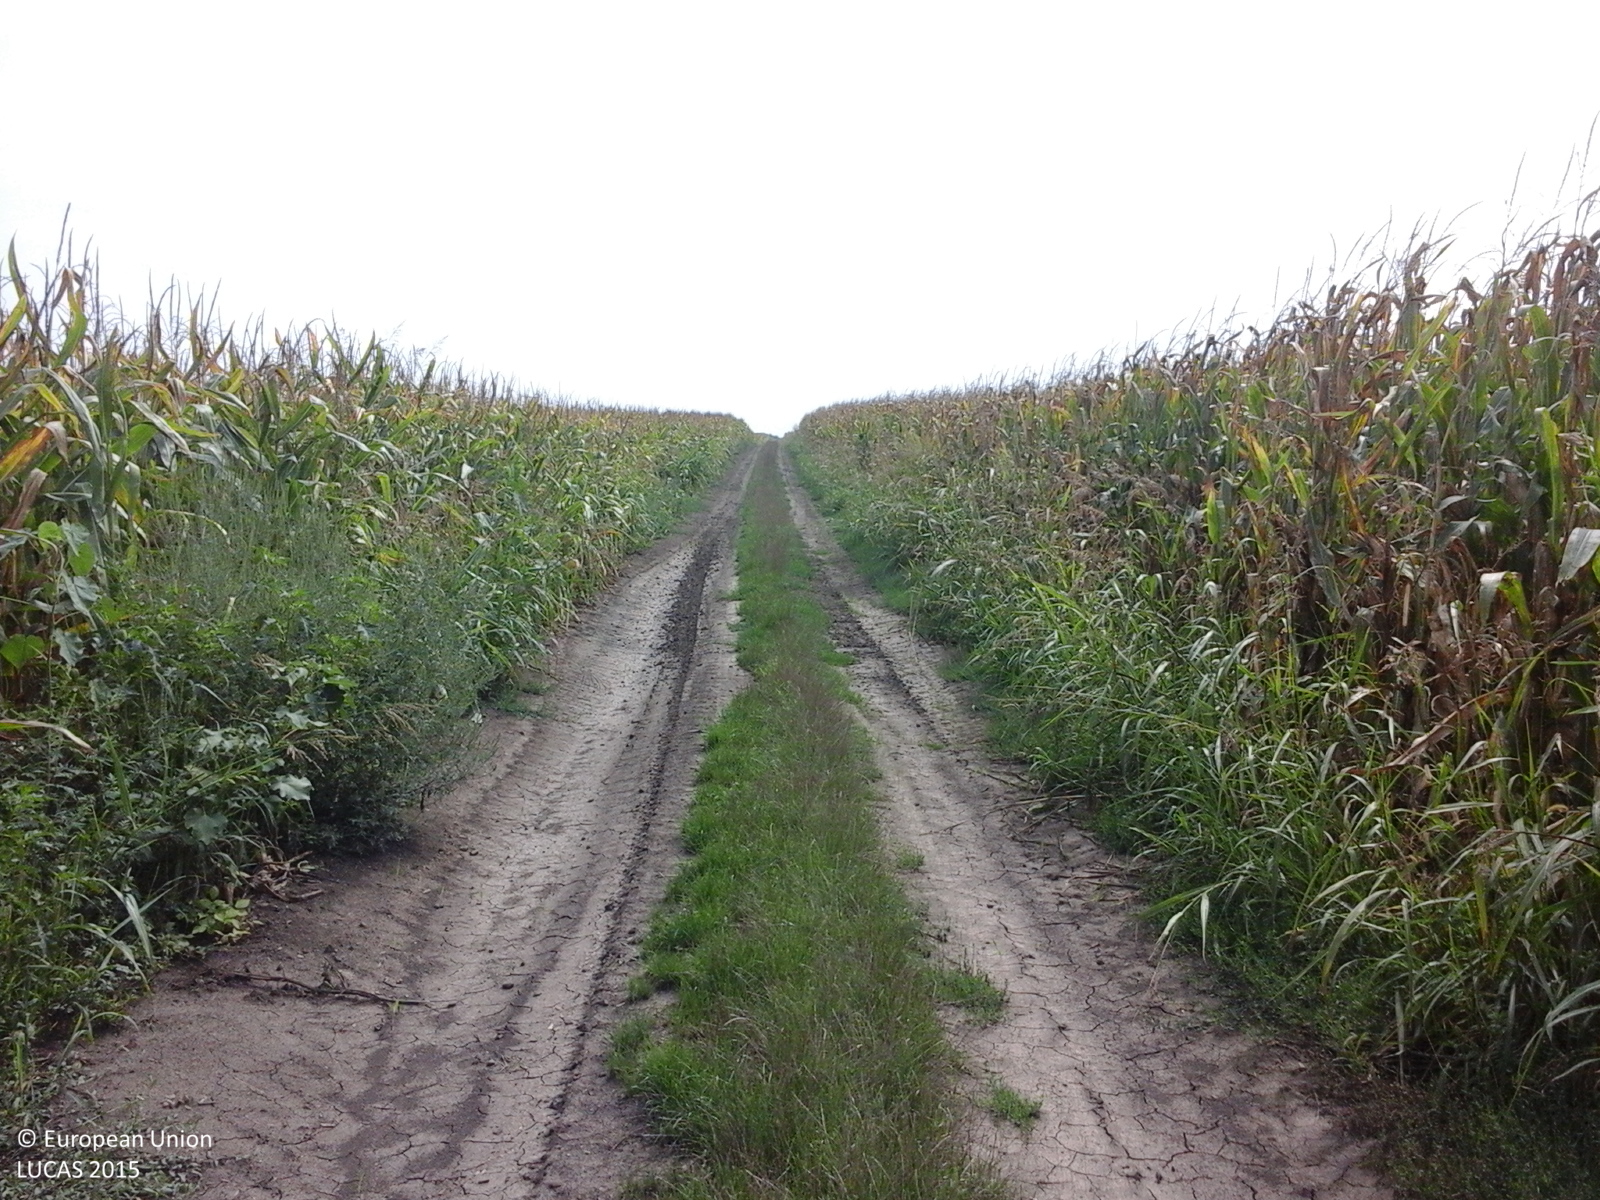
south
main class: Cropland
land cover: Maize
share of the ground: > 75 %
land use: Agriculture (excluding fallow land and kitchen gardens)
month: August
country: RO
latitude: 46.2659
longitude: 20.8893
